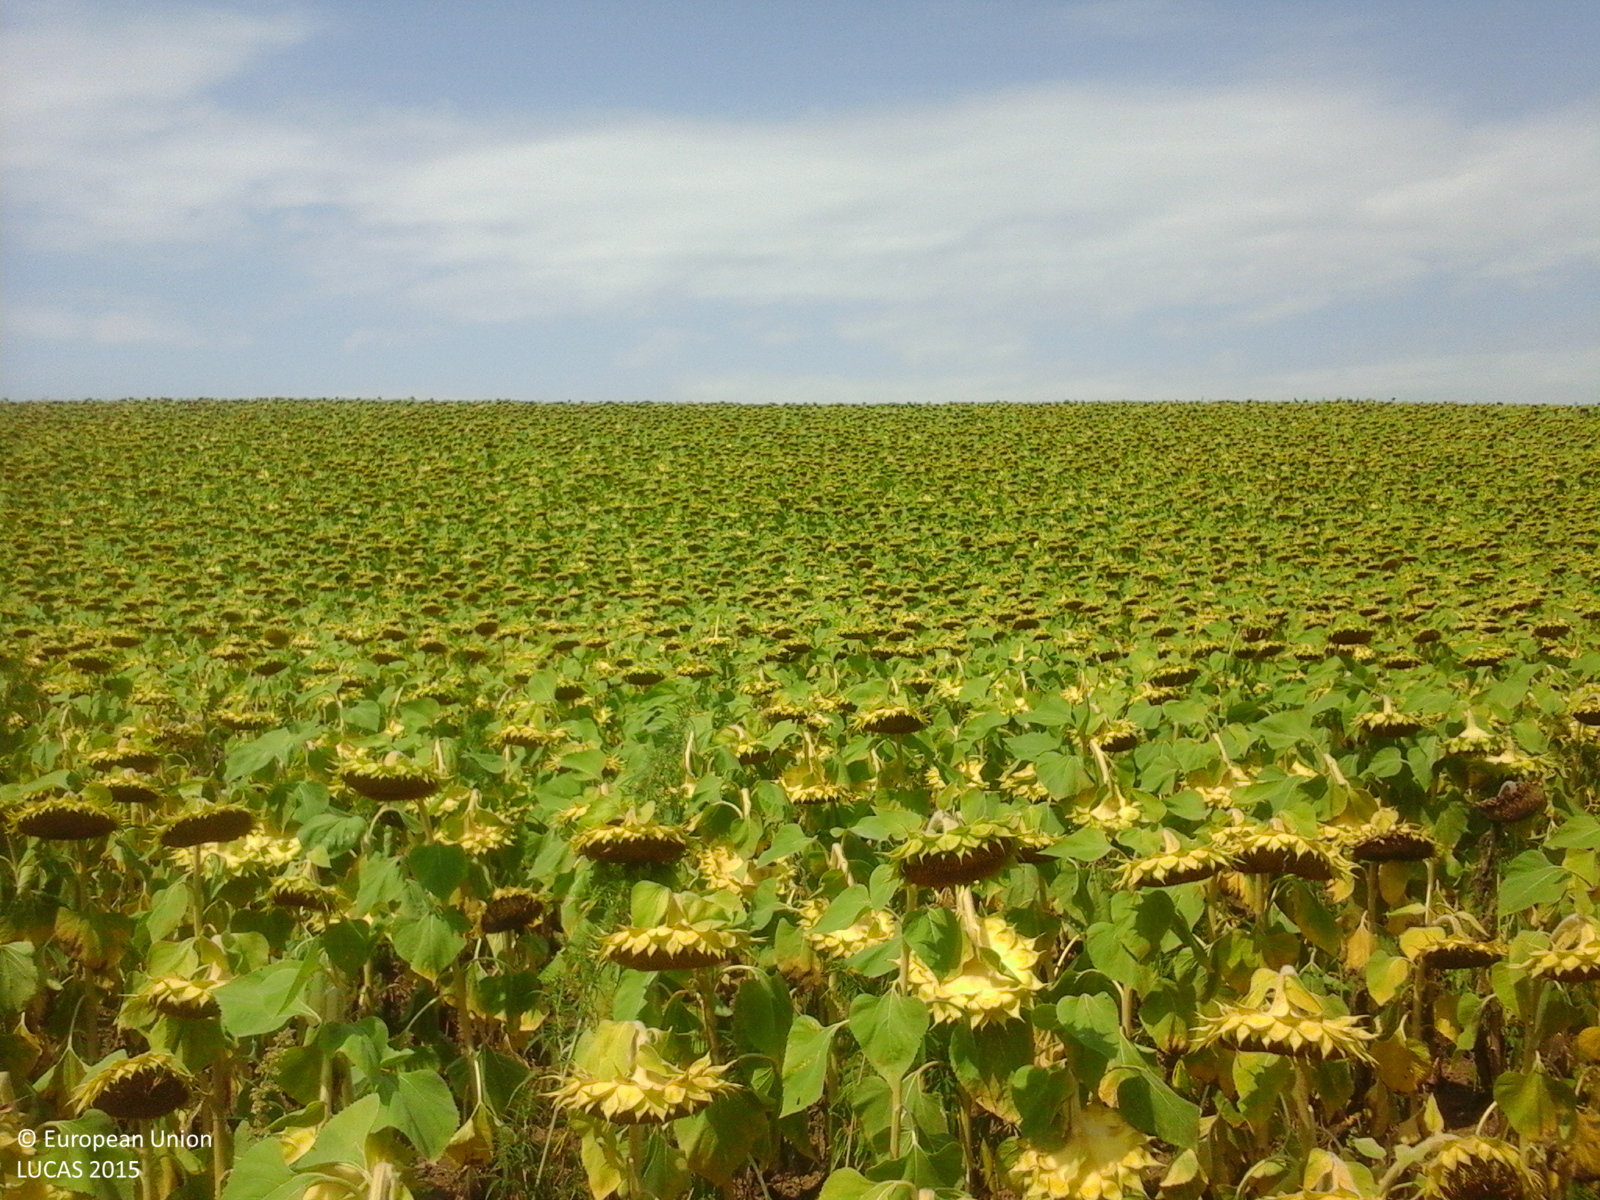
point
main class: Cropland
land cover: Sunflower
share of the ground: > 75 %
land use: Agriculture (excluding fallow land and kitchen gardens)
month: August
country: RO
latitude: 44.0005
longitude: 27.7664
